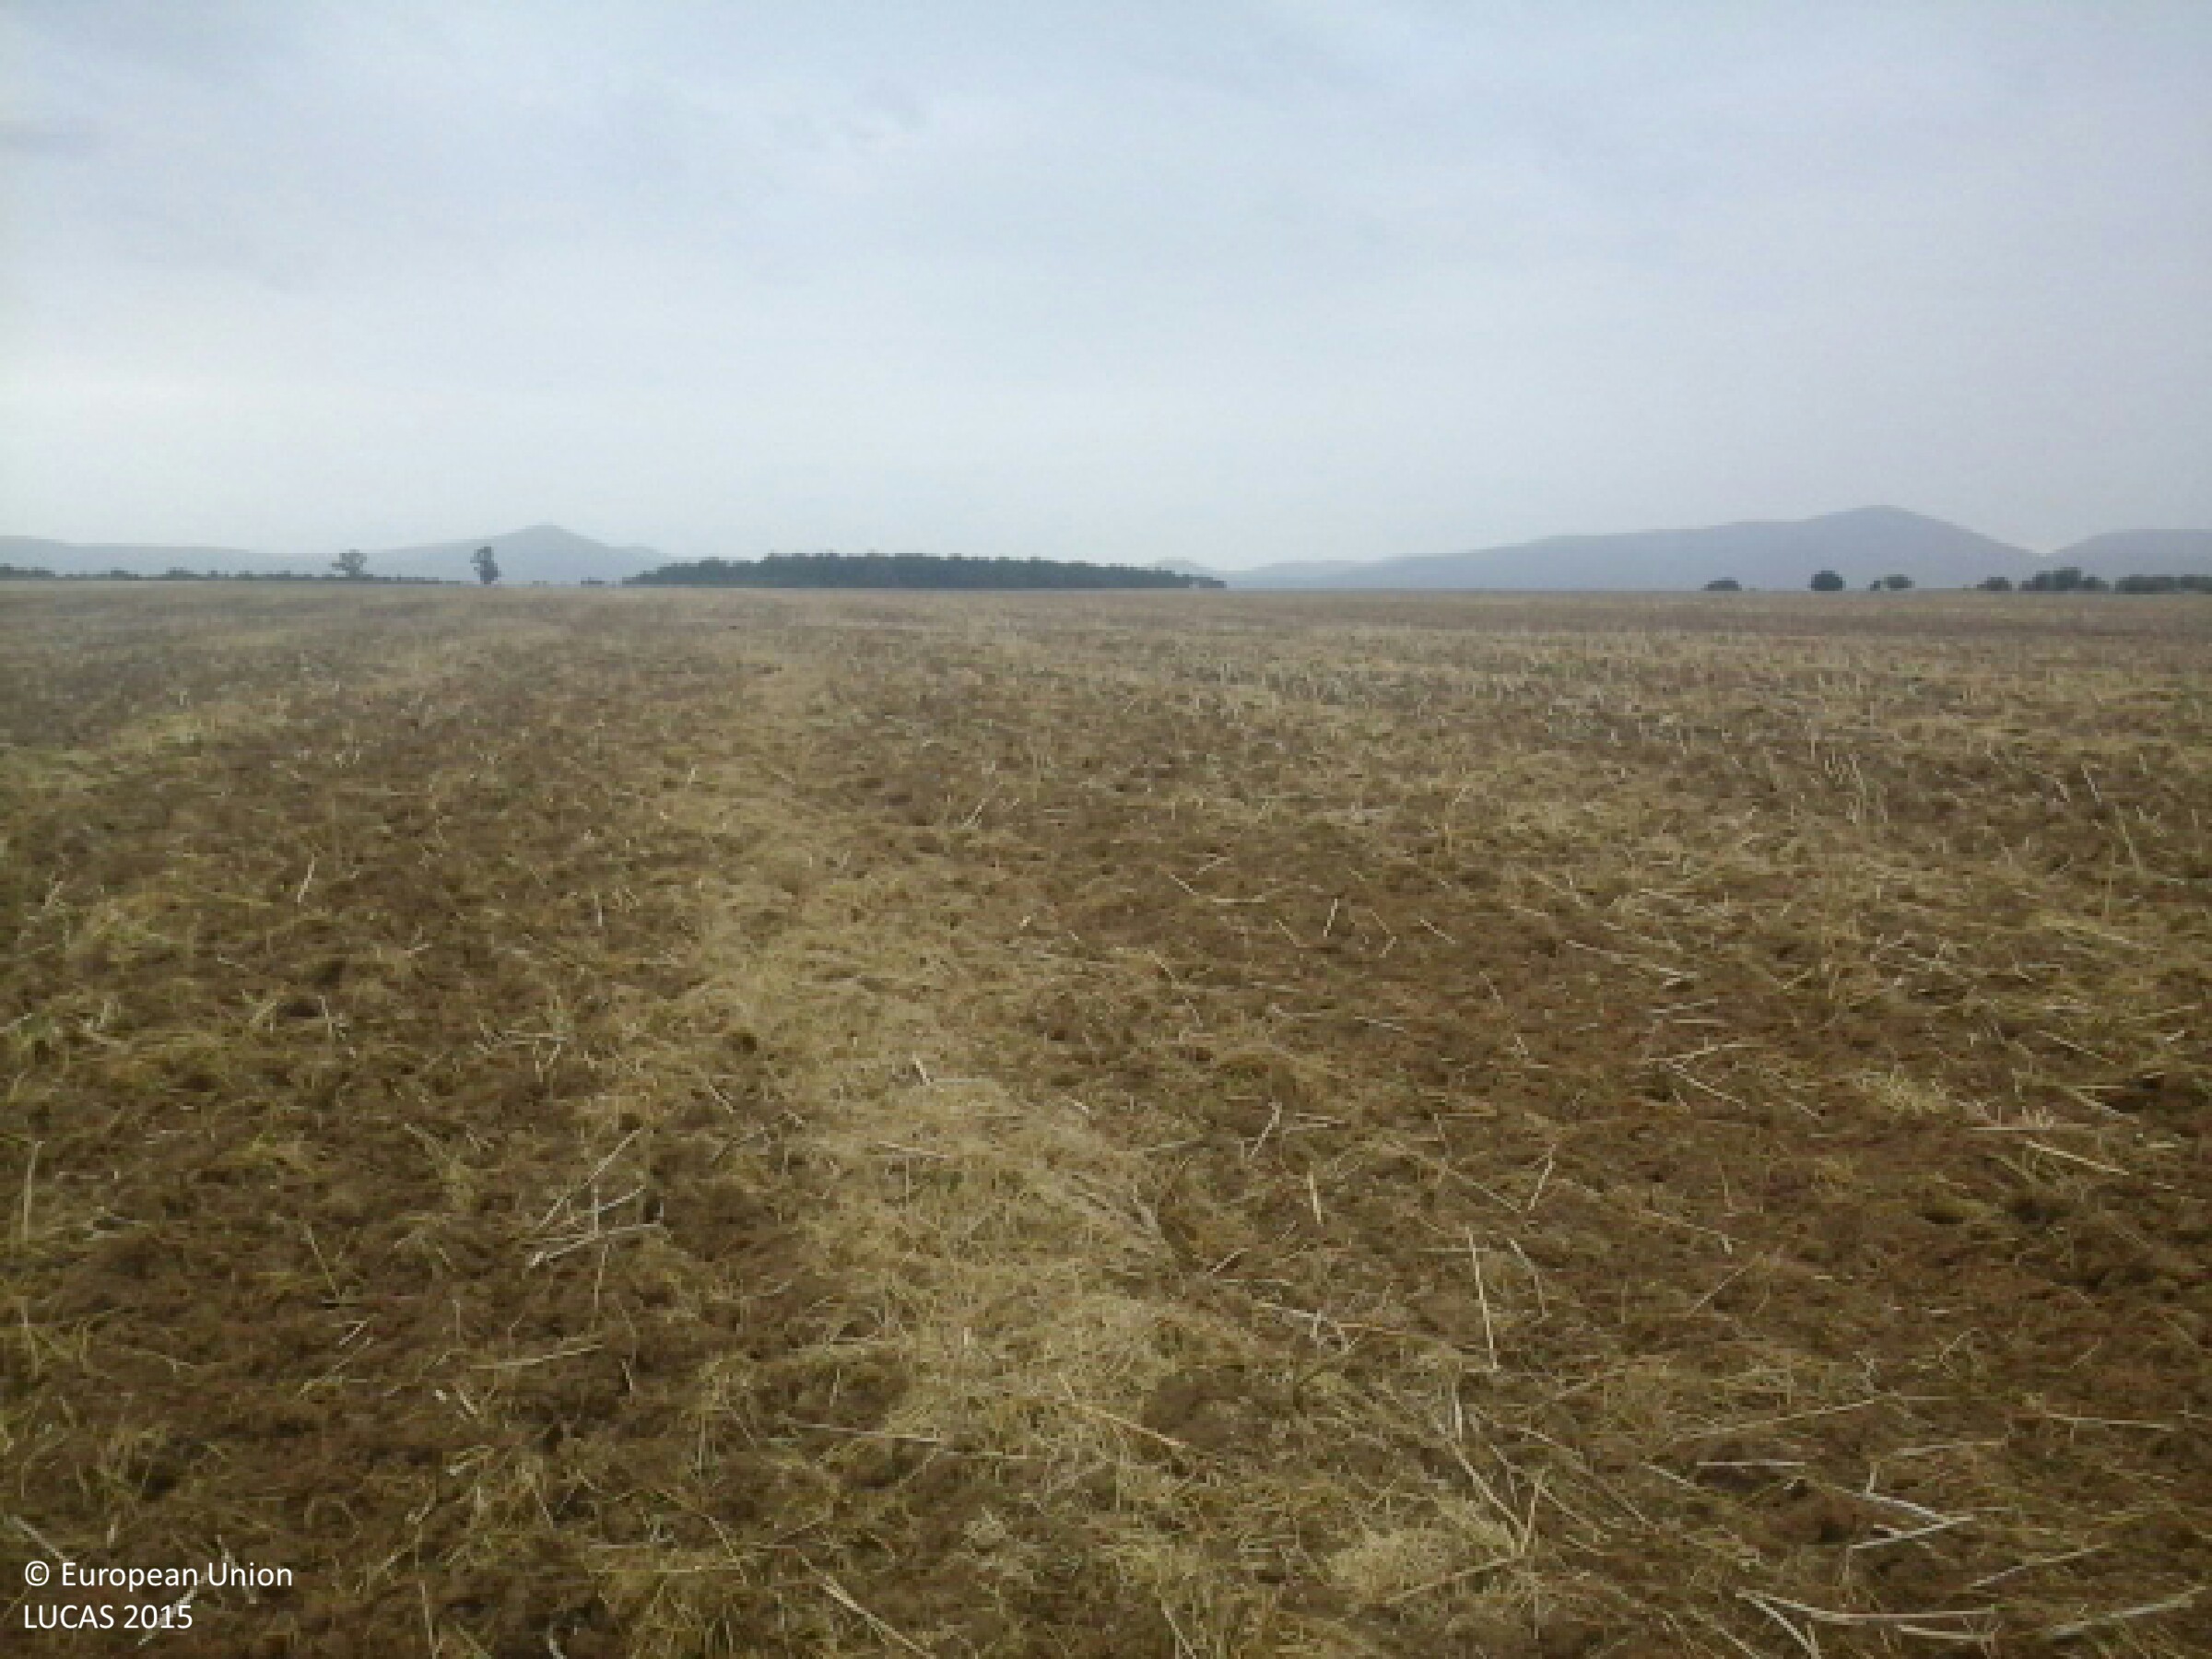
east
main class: Cropland
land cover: Rape and turnip rape
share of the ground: < 10 %
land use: Agriculture (excluding fallow land and kitchen gardens)
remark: Harvested field
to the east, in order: Rape and turnip rape
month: July
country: HU
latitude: 48.4025
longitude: 21.1319
